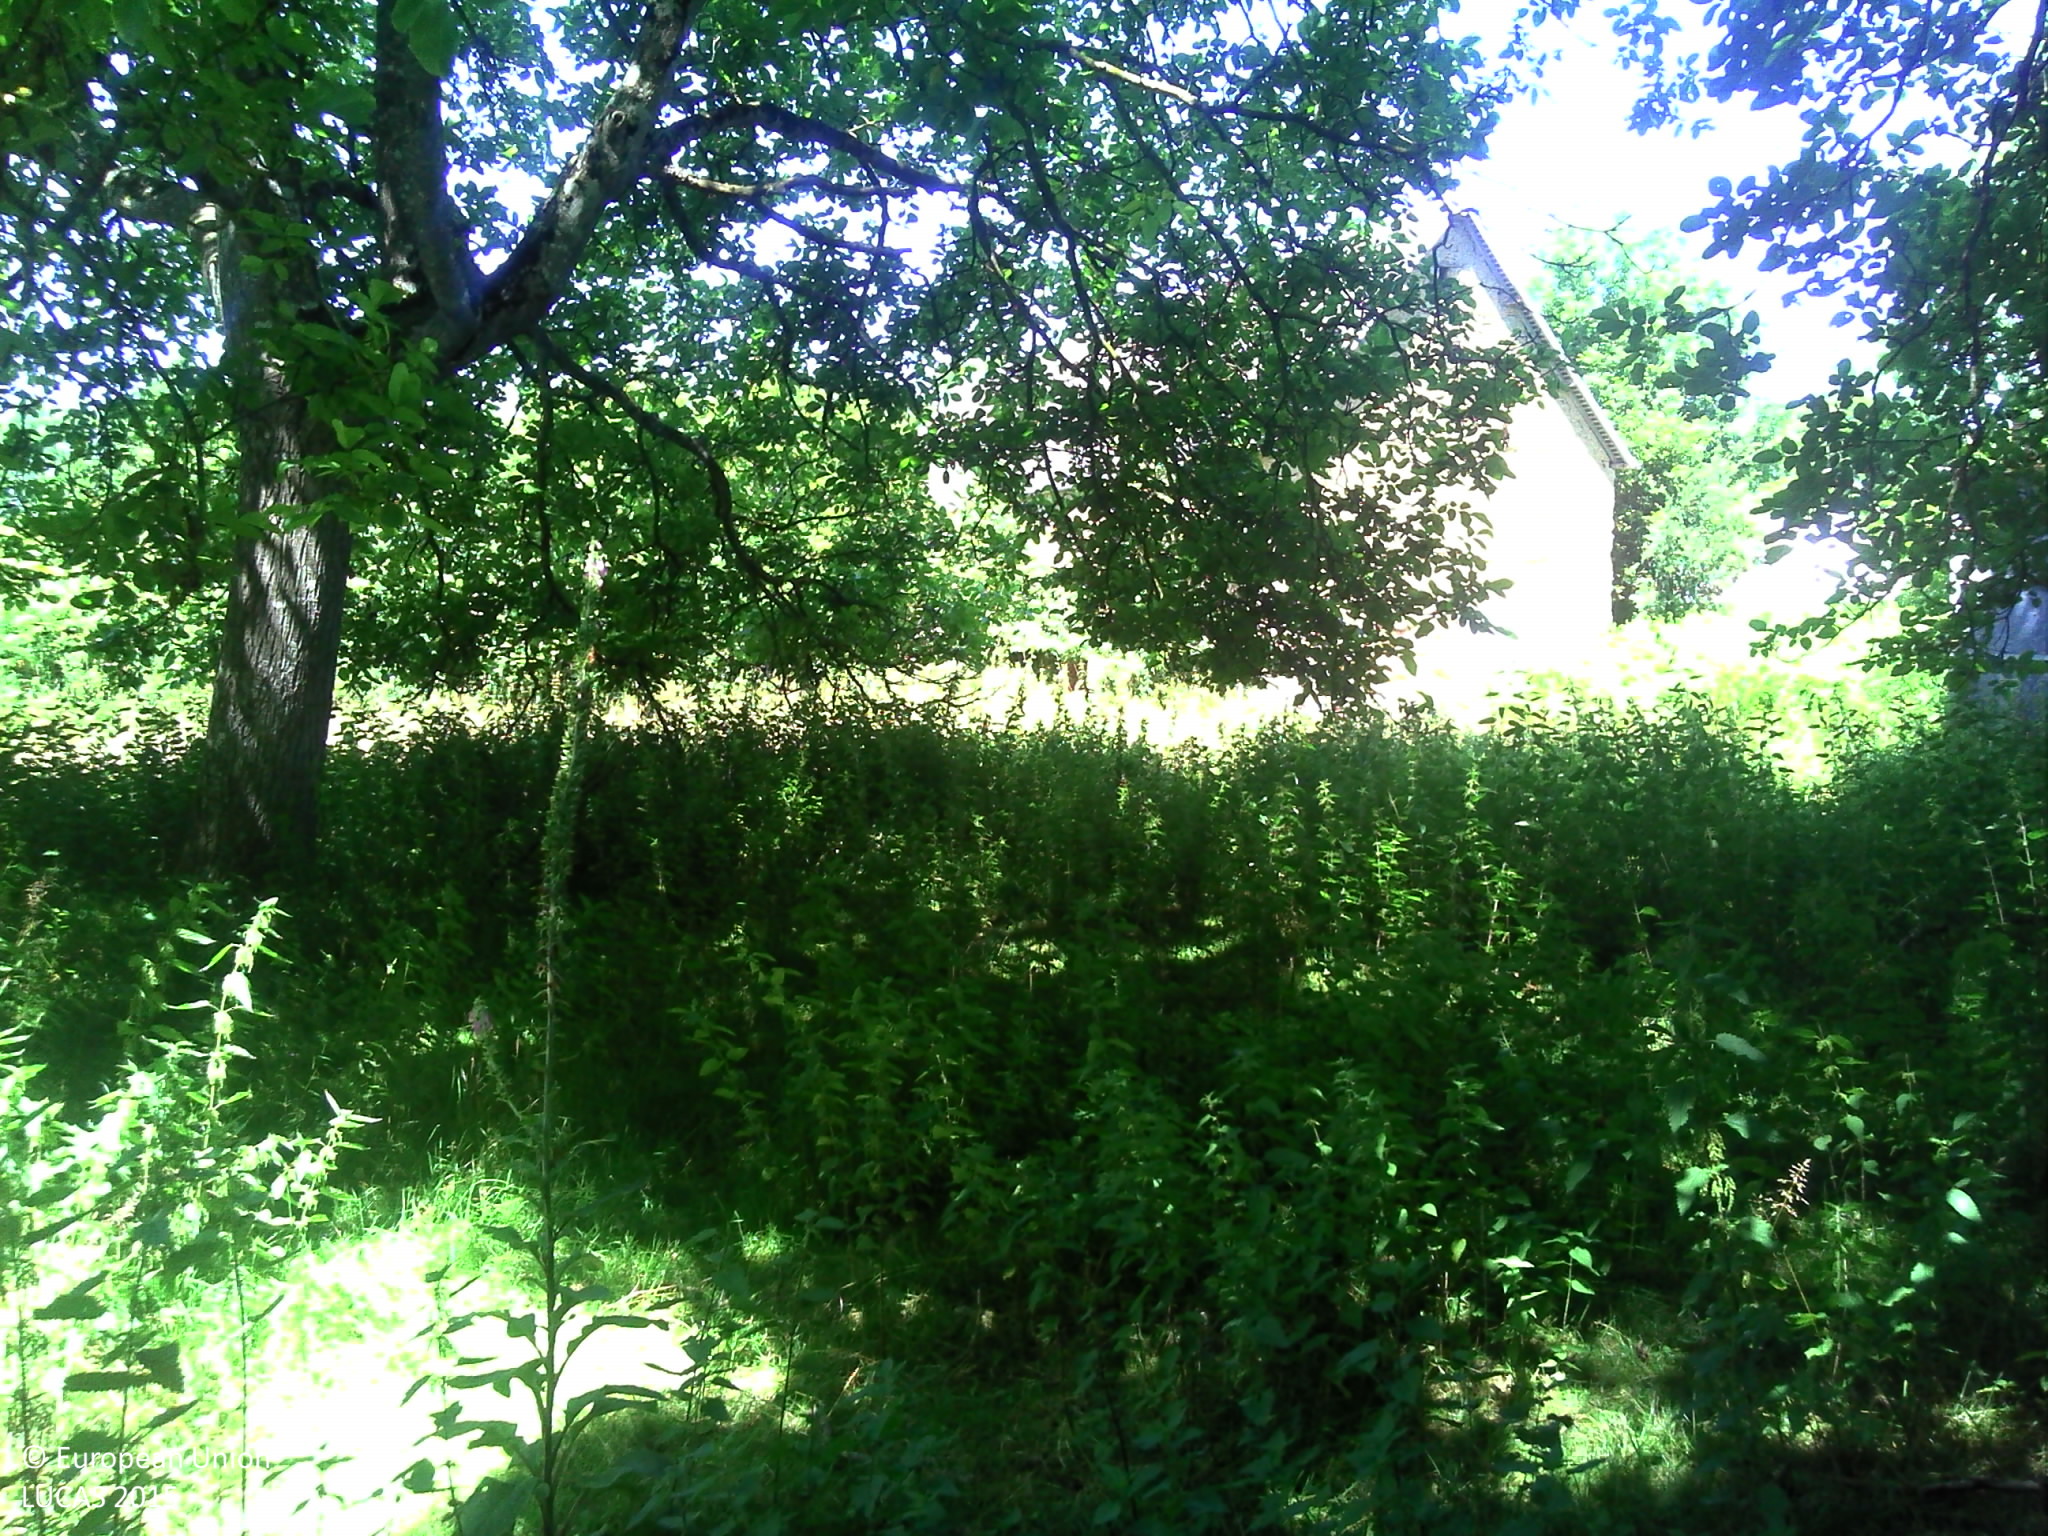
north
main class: Cropland
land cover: Nuts trees
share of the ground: > 75 %
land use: Agriculture (excluding fallow land and kitchen gardens)
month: July
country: FR
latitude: 49.0510
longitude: -1.3624
